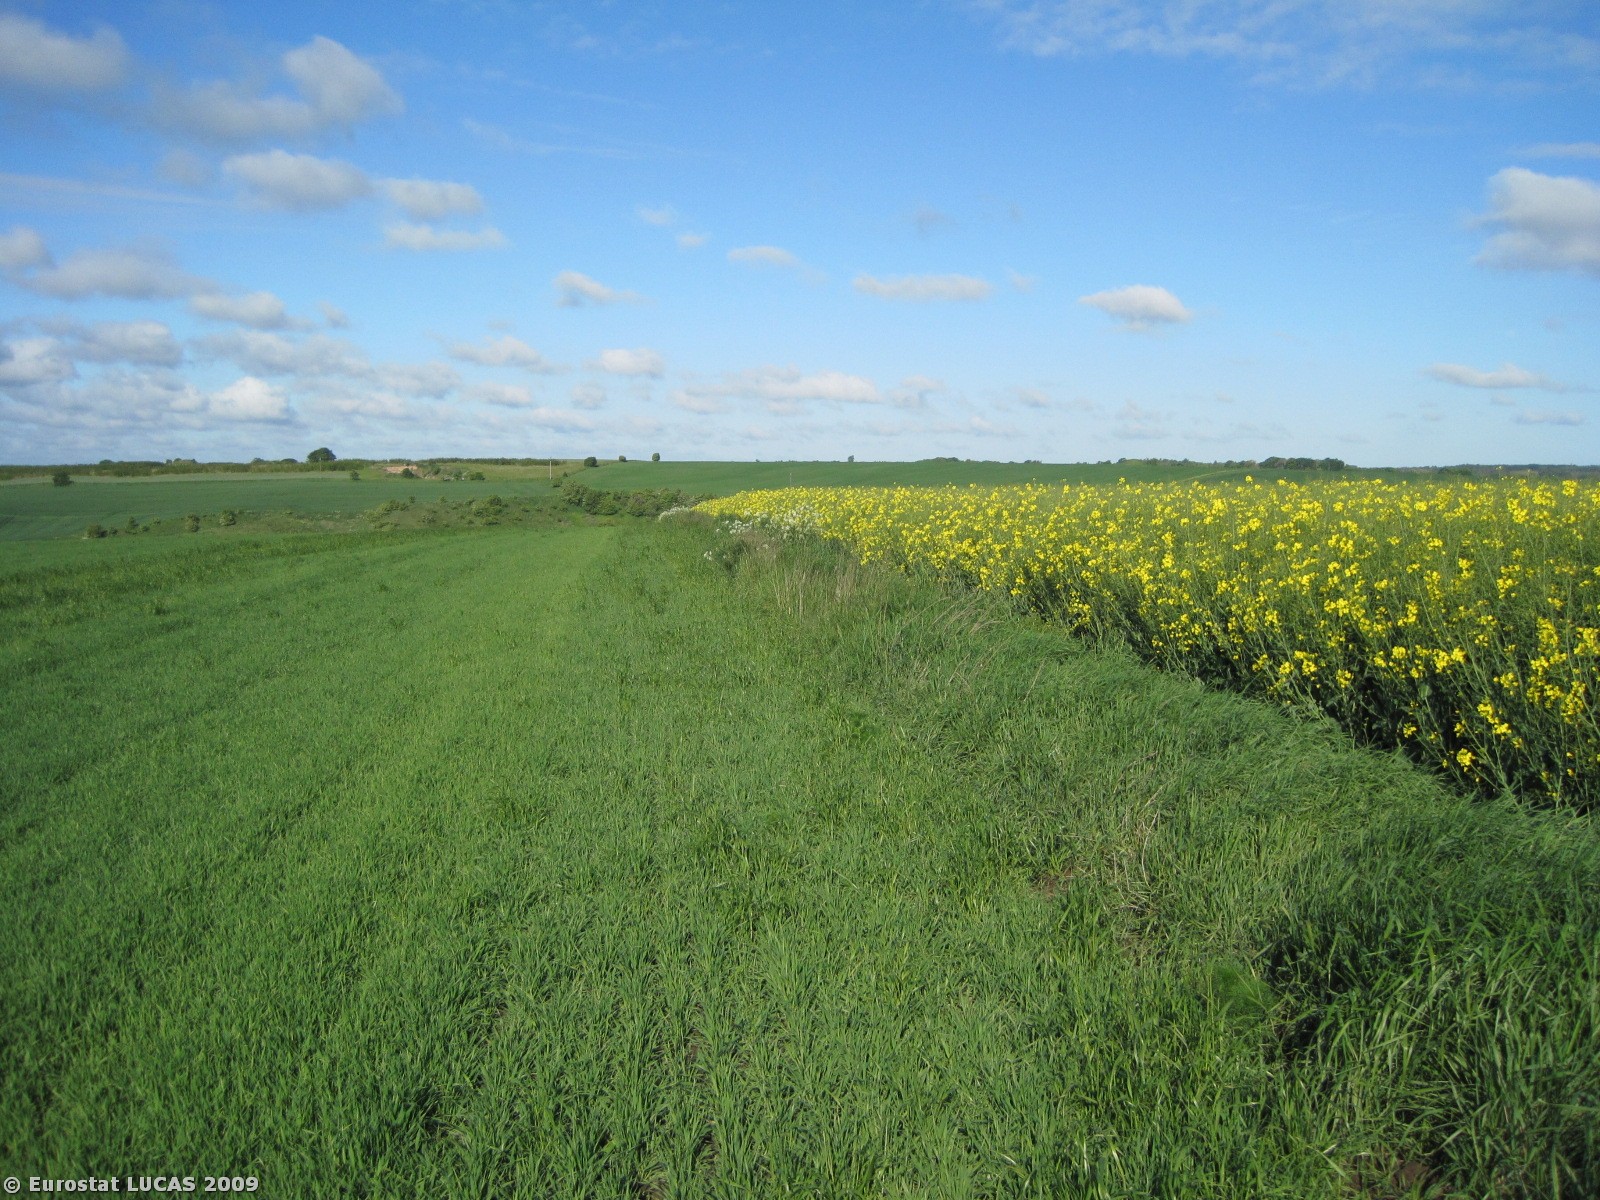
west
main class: Cropland
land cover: Barley
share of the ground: > 75 %
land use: Agriculture (excluding fallow land and kitchen gardens)
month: May
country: DK
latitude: 56.8888
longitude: 9.9836
